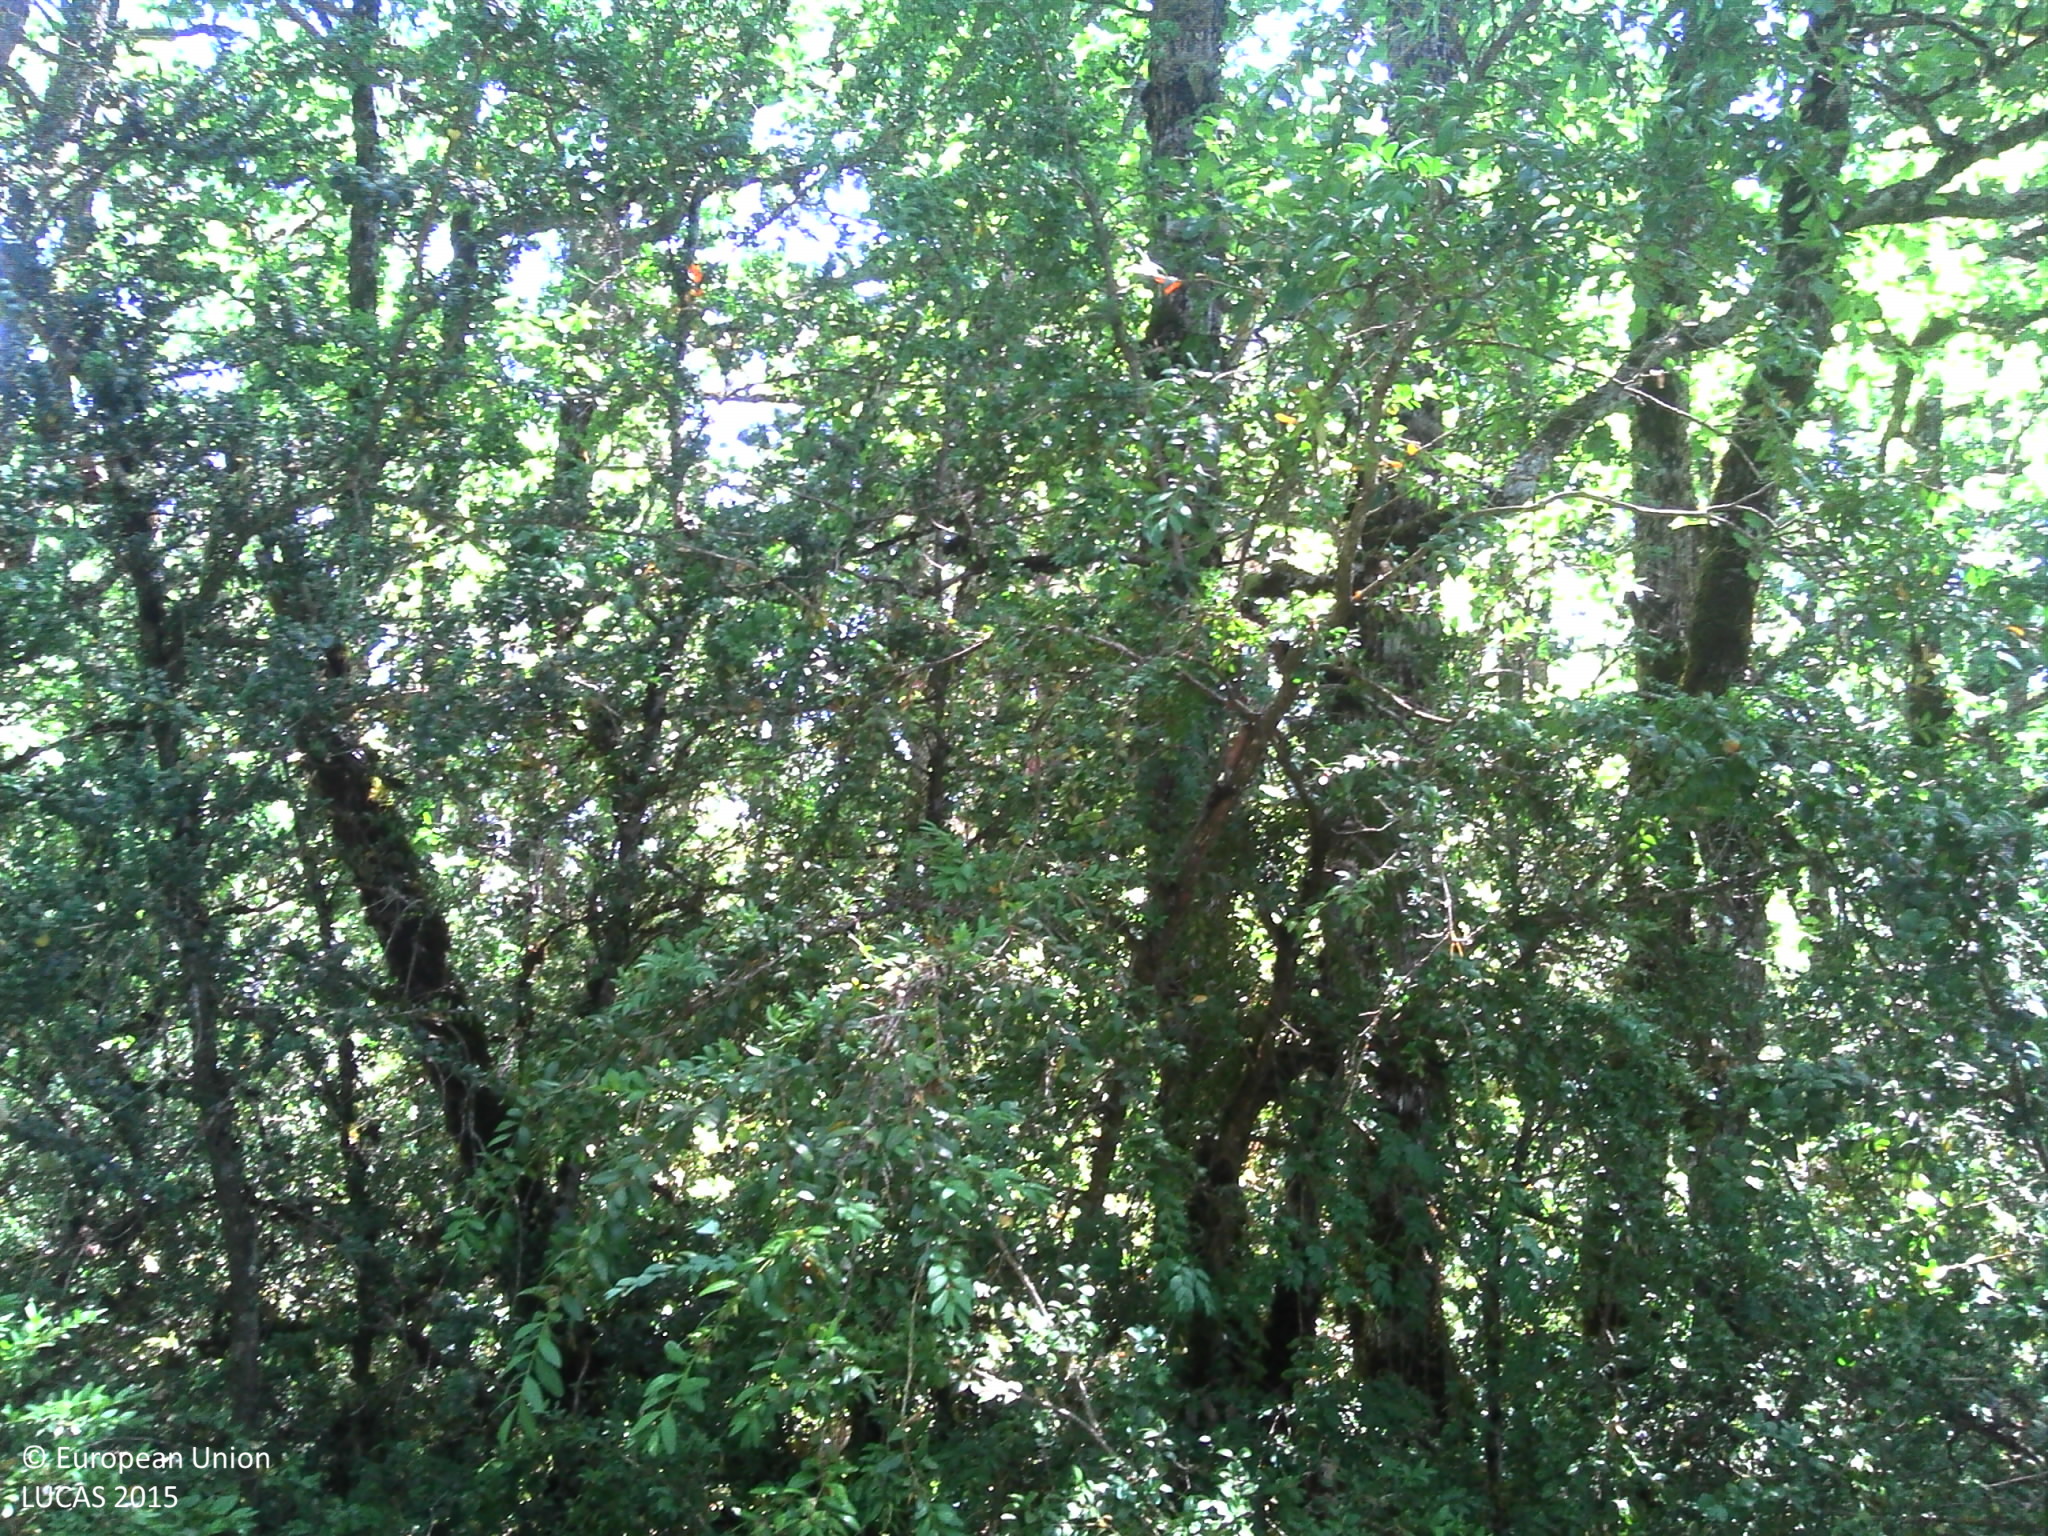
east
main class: Woodland
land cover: Other mixed woodland
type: hemiboreal forest and nemoral coniferous forest and mixed broadleaved-coniferous forest
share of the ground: > 75 %
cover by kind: broadleaved forest trees 75 %, coniferous forest trees 25 %
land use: Forestry
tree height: > 5 m
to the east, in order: Other mixed woodland; Shrubland with sparse tree cover; Tracks; Abandoned hedges; Fences; Lucerne
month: July
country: FR
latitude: 44.3996
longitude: 3.2125
